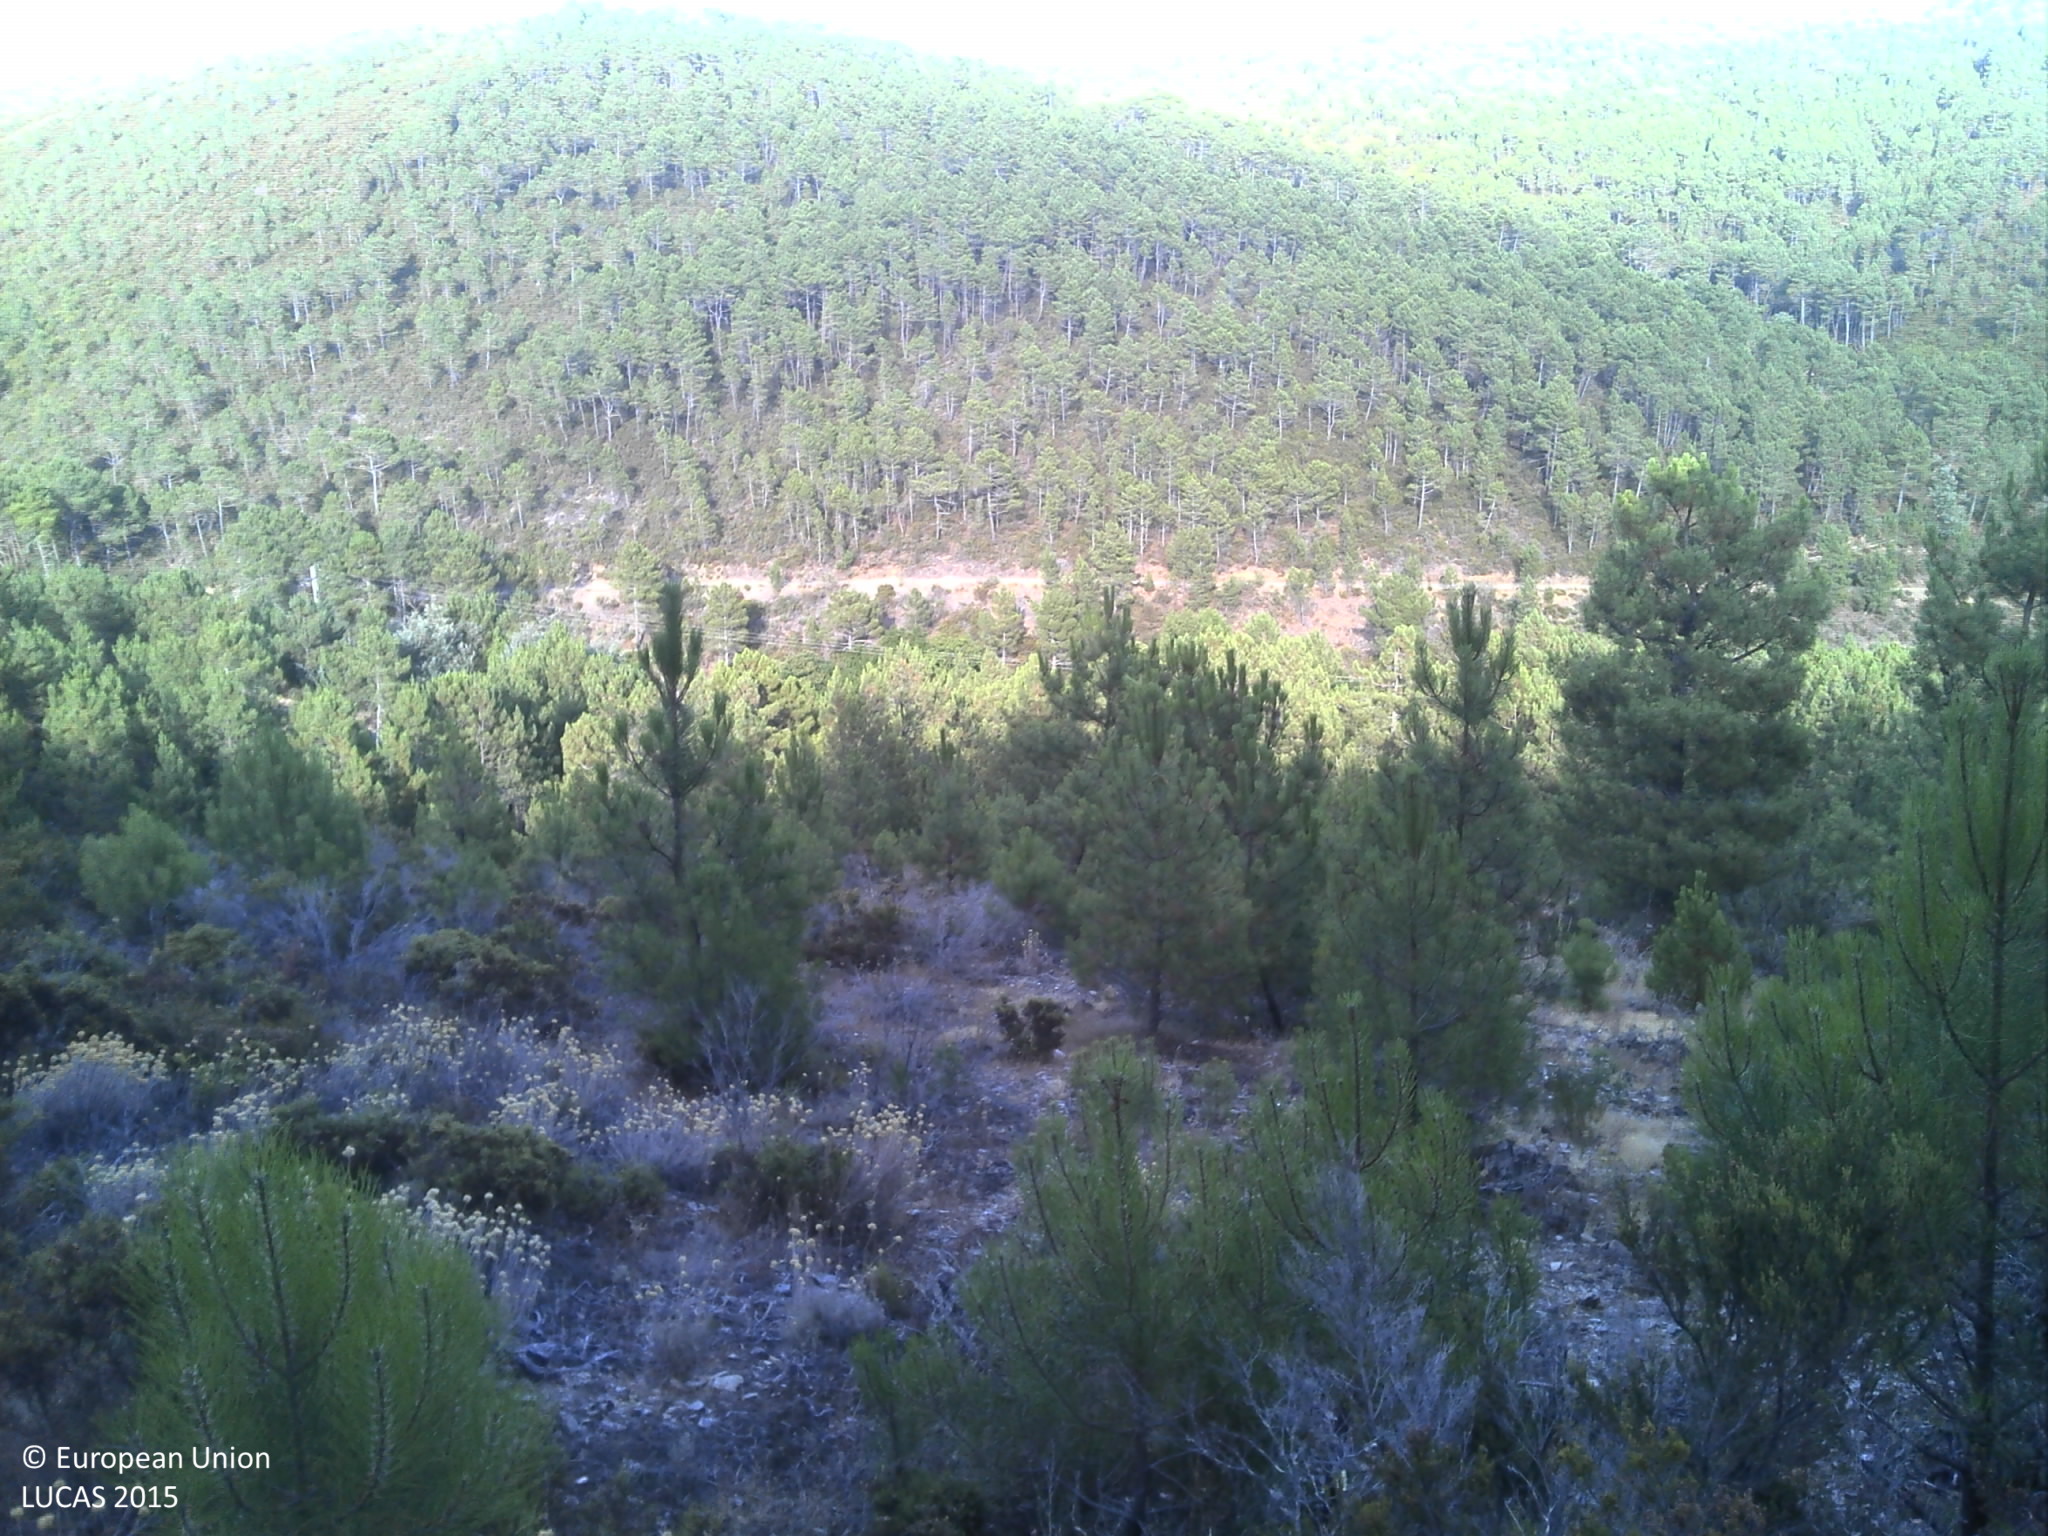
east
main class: Shrubland
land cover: Shrubland with sparse tree cover
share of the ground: 25 - 50 %
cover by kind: unconsolidated bare surface 55 %, shrubs 30 %, herbaceous plants 10 %, coniferous forest trees 5 %
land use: Abandoned areas
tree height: < 5 m
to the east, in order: Shrubland with sparse tree cover; Pine dominated coniferous woodland; Grass margins; Paved roads, cycling and walking lanes; Grass margins; Pine dominated coniferous woodland; Tracks; Dry stone walls; Other fruit trees and berries; Electric lines; Grassland without tree/shrub cover; Pine dominated coniferous woodland
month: July
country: PT
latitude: 40.1568
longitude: -7.8052
